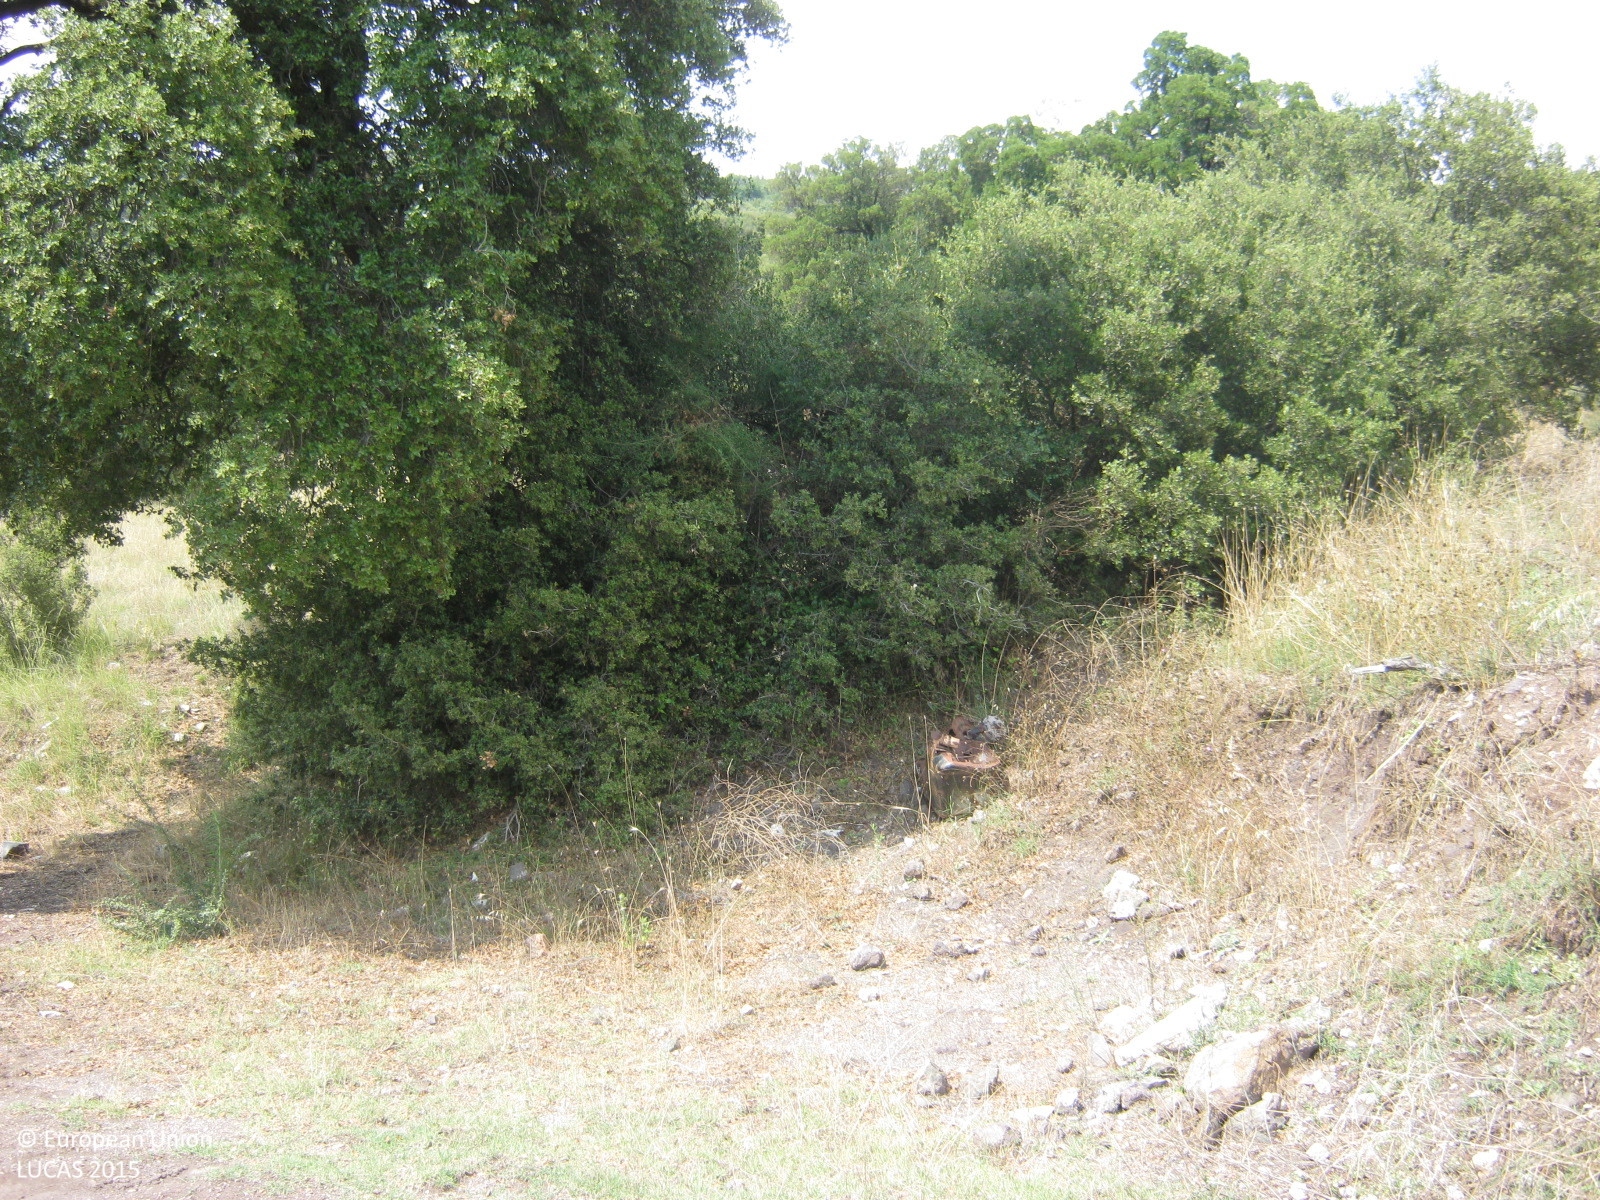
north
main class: Woodland
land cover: Broadleaved woodland
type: thermophilous deciduous forest
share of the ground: > 75 %
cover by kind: broadleaved forest trees 90 %, shrubs 5 %, herbaceous plants 5 %
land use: Forestry
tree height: > 5 m
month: August
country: GR
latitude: 37.4044
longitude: 22.0121
